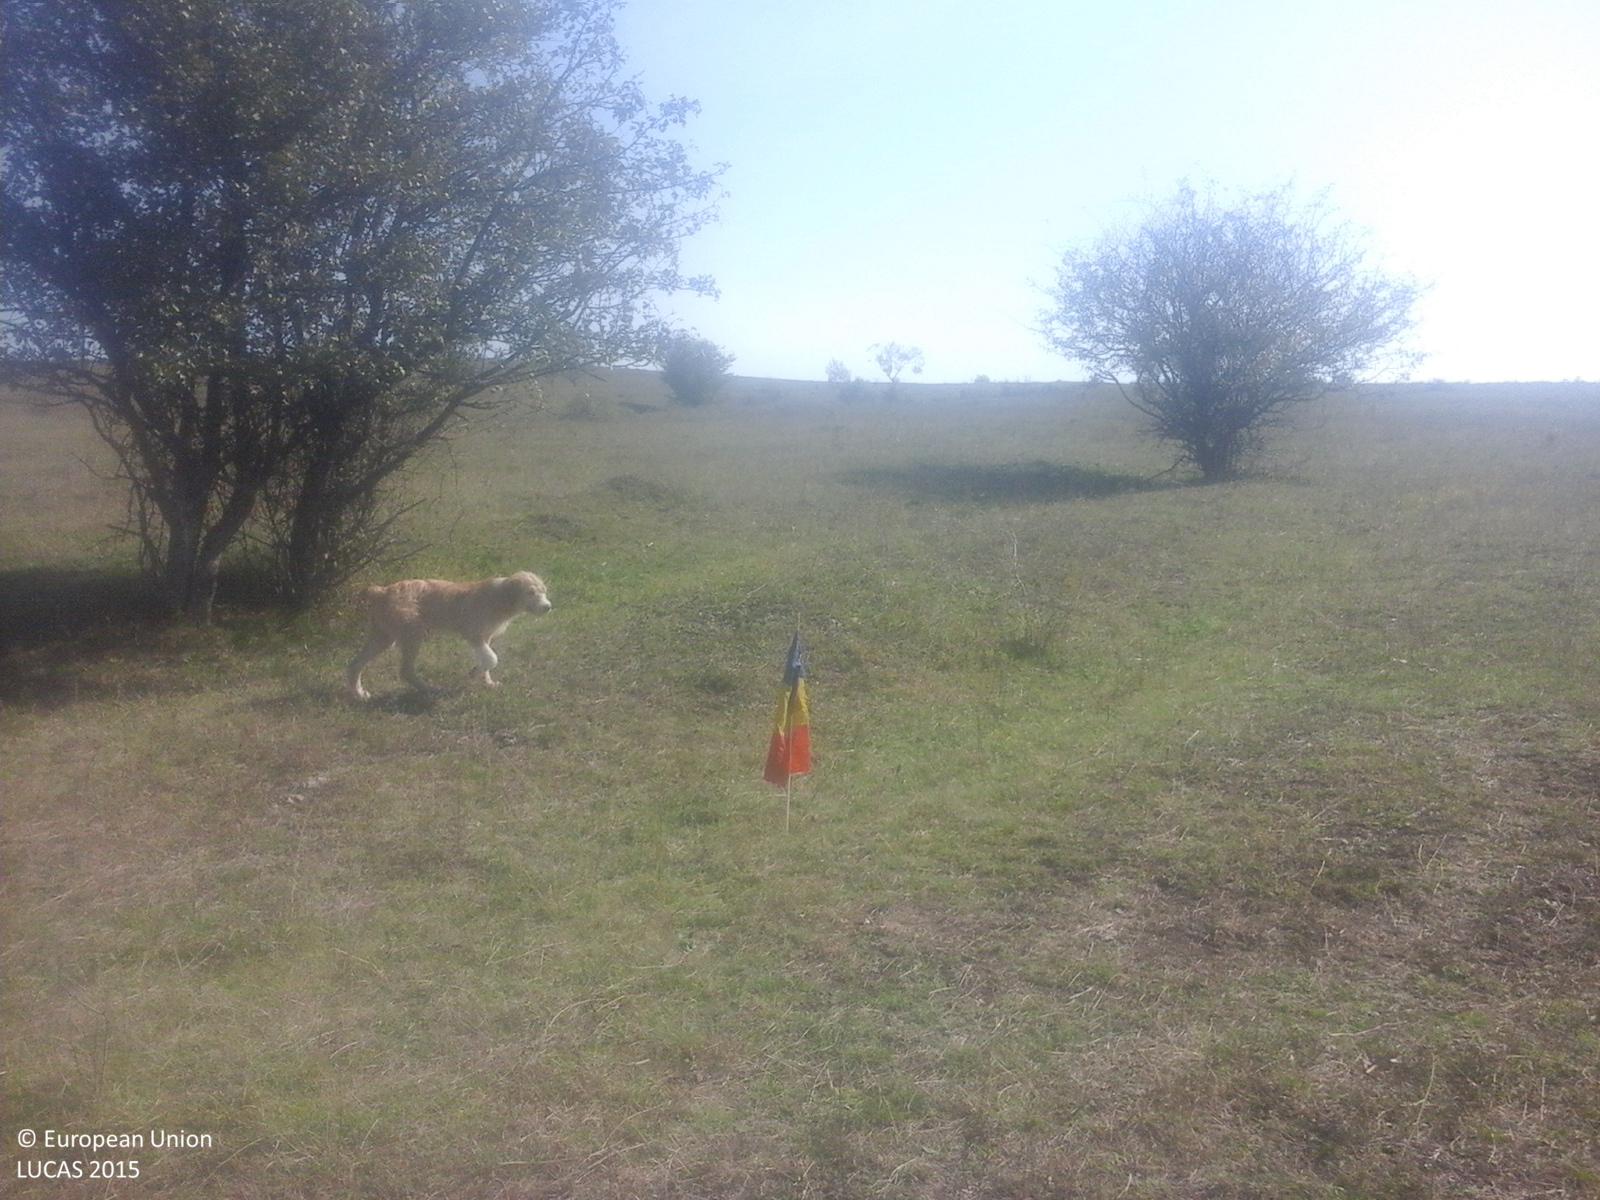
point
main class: Grassland
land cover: Grassland with sparse tree/shrub cover
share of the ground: > 75 %
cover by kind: herbaceous plants 85 %, shrubs 10 %, broadleaved forest trees 5 %
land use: Agriculture (excluding fallow land and kitchen gardens)
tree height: > 5 m
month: October
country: RO
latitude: 46.0110
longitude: 23.8511
